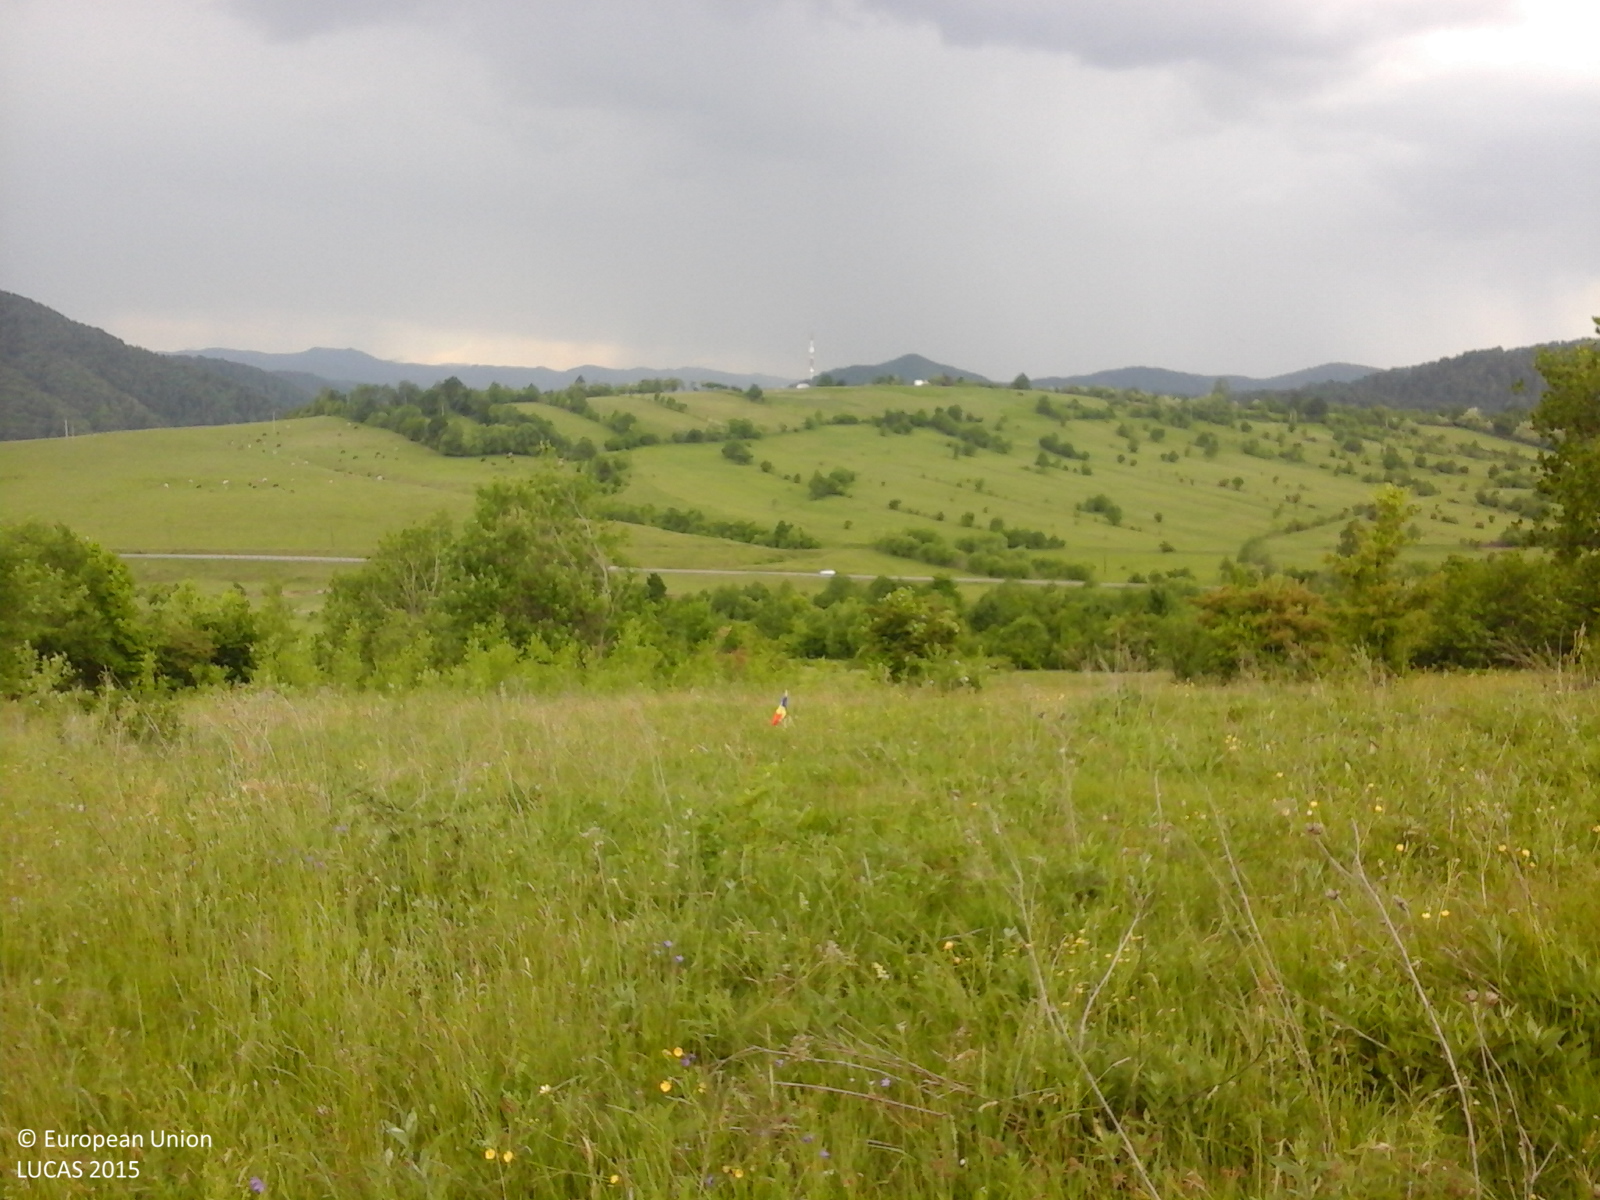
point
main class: Grassland
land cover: Grassland without tree/shrub cover
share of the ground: > 75 %
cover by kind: herbaceous plants 95 %, shrubs 5 %
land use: Agriculture (excluding fallow land and kitchen gardens)
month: June
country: RO
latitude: 46.7331
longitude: 26.4802
